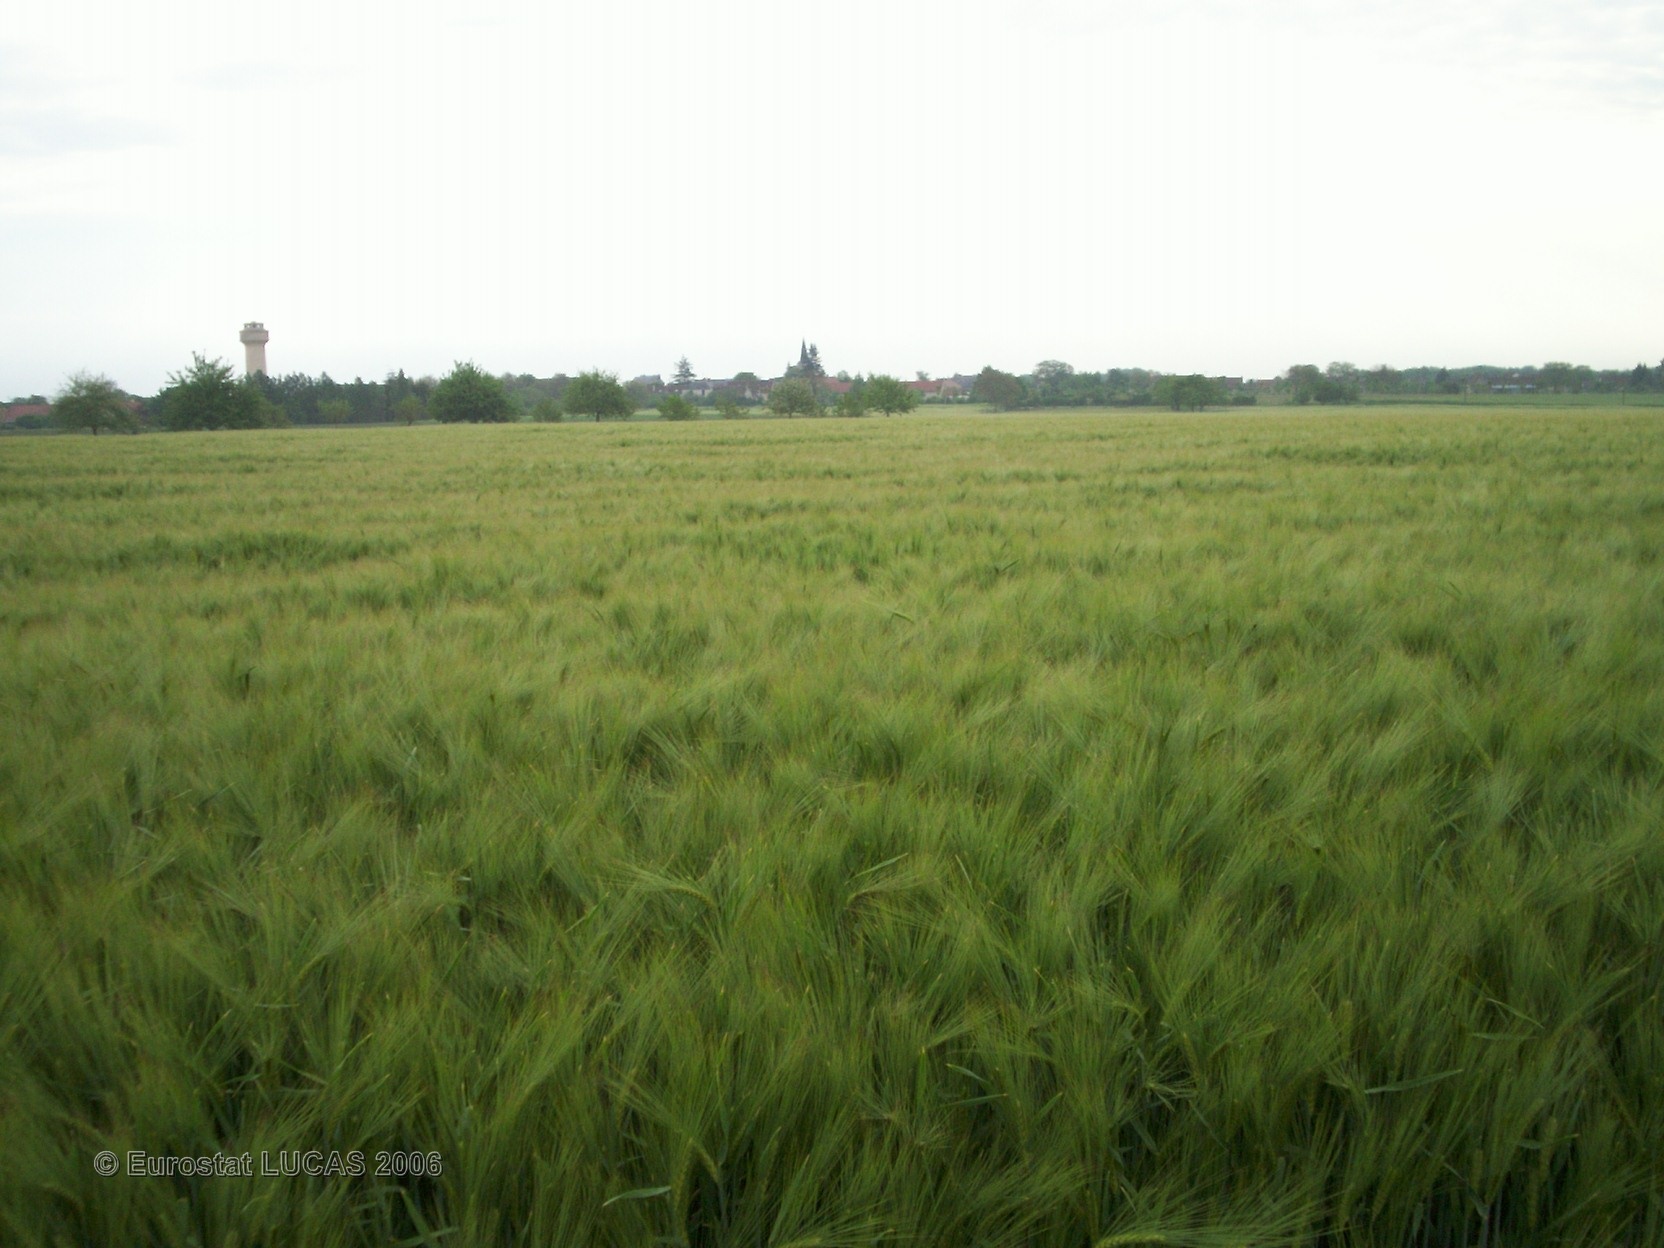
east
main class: Cropland
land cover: Barley
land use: Agriculture (excluding fallow land and kitchen gardens)
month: May
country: FR
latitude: 46.6803
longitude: 1.0305
